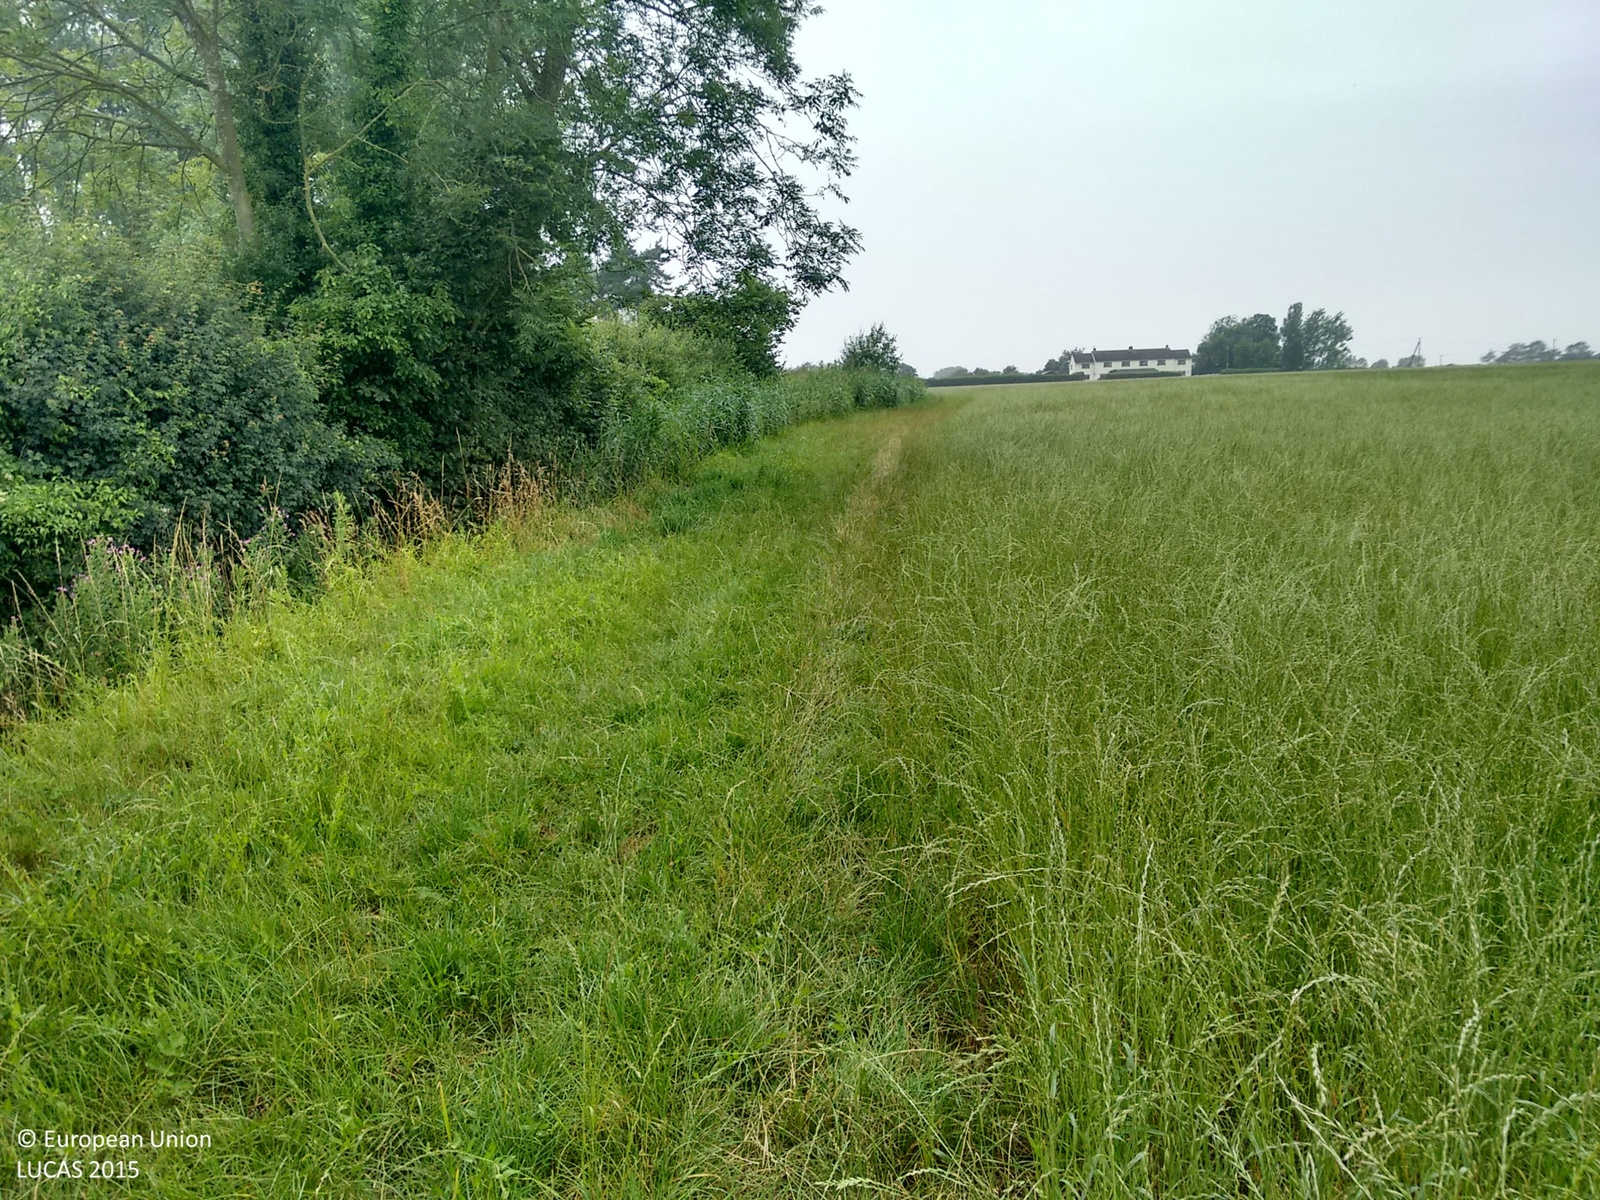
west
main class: Cropland
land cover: Temporary grasslands
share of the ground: > 75 %
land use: Agriculture (excluding fallow land and kitchen gardens)
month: July
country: GB
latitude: 51.7495
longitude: 0.3674
